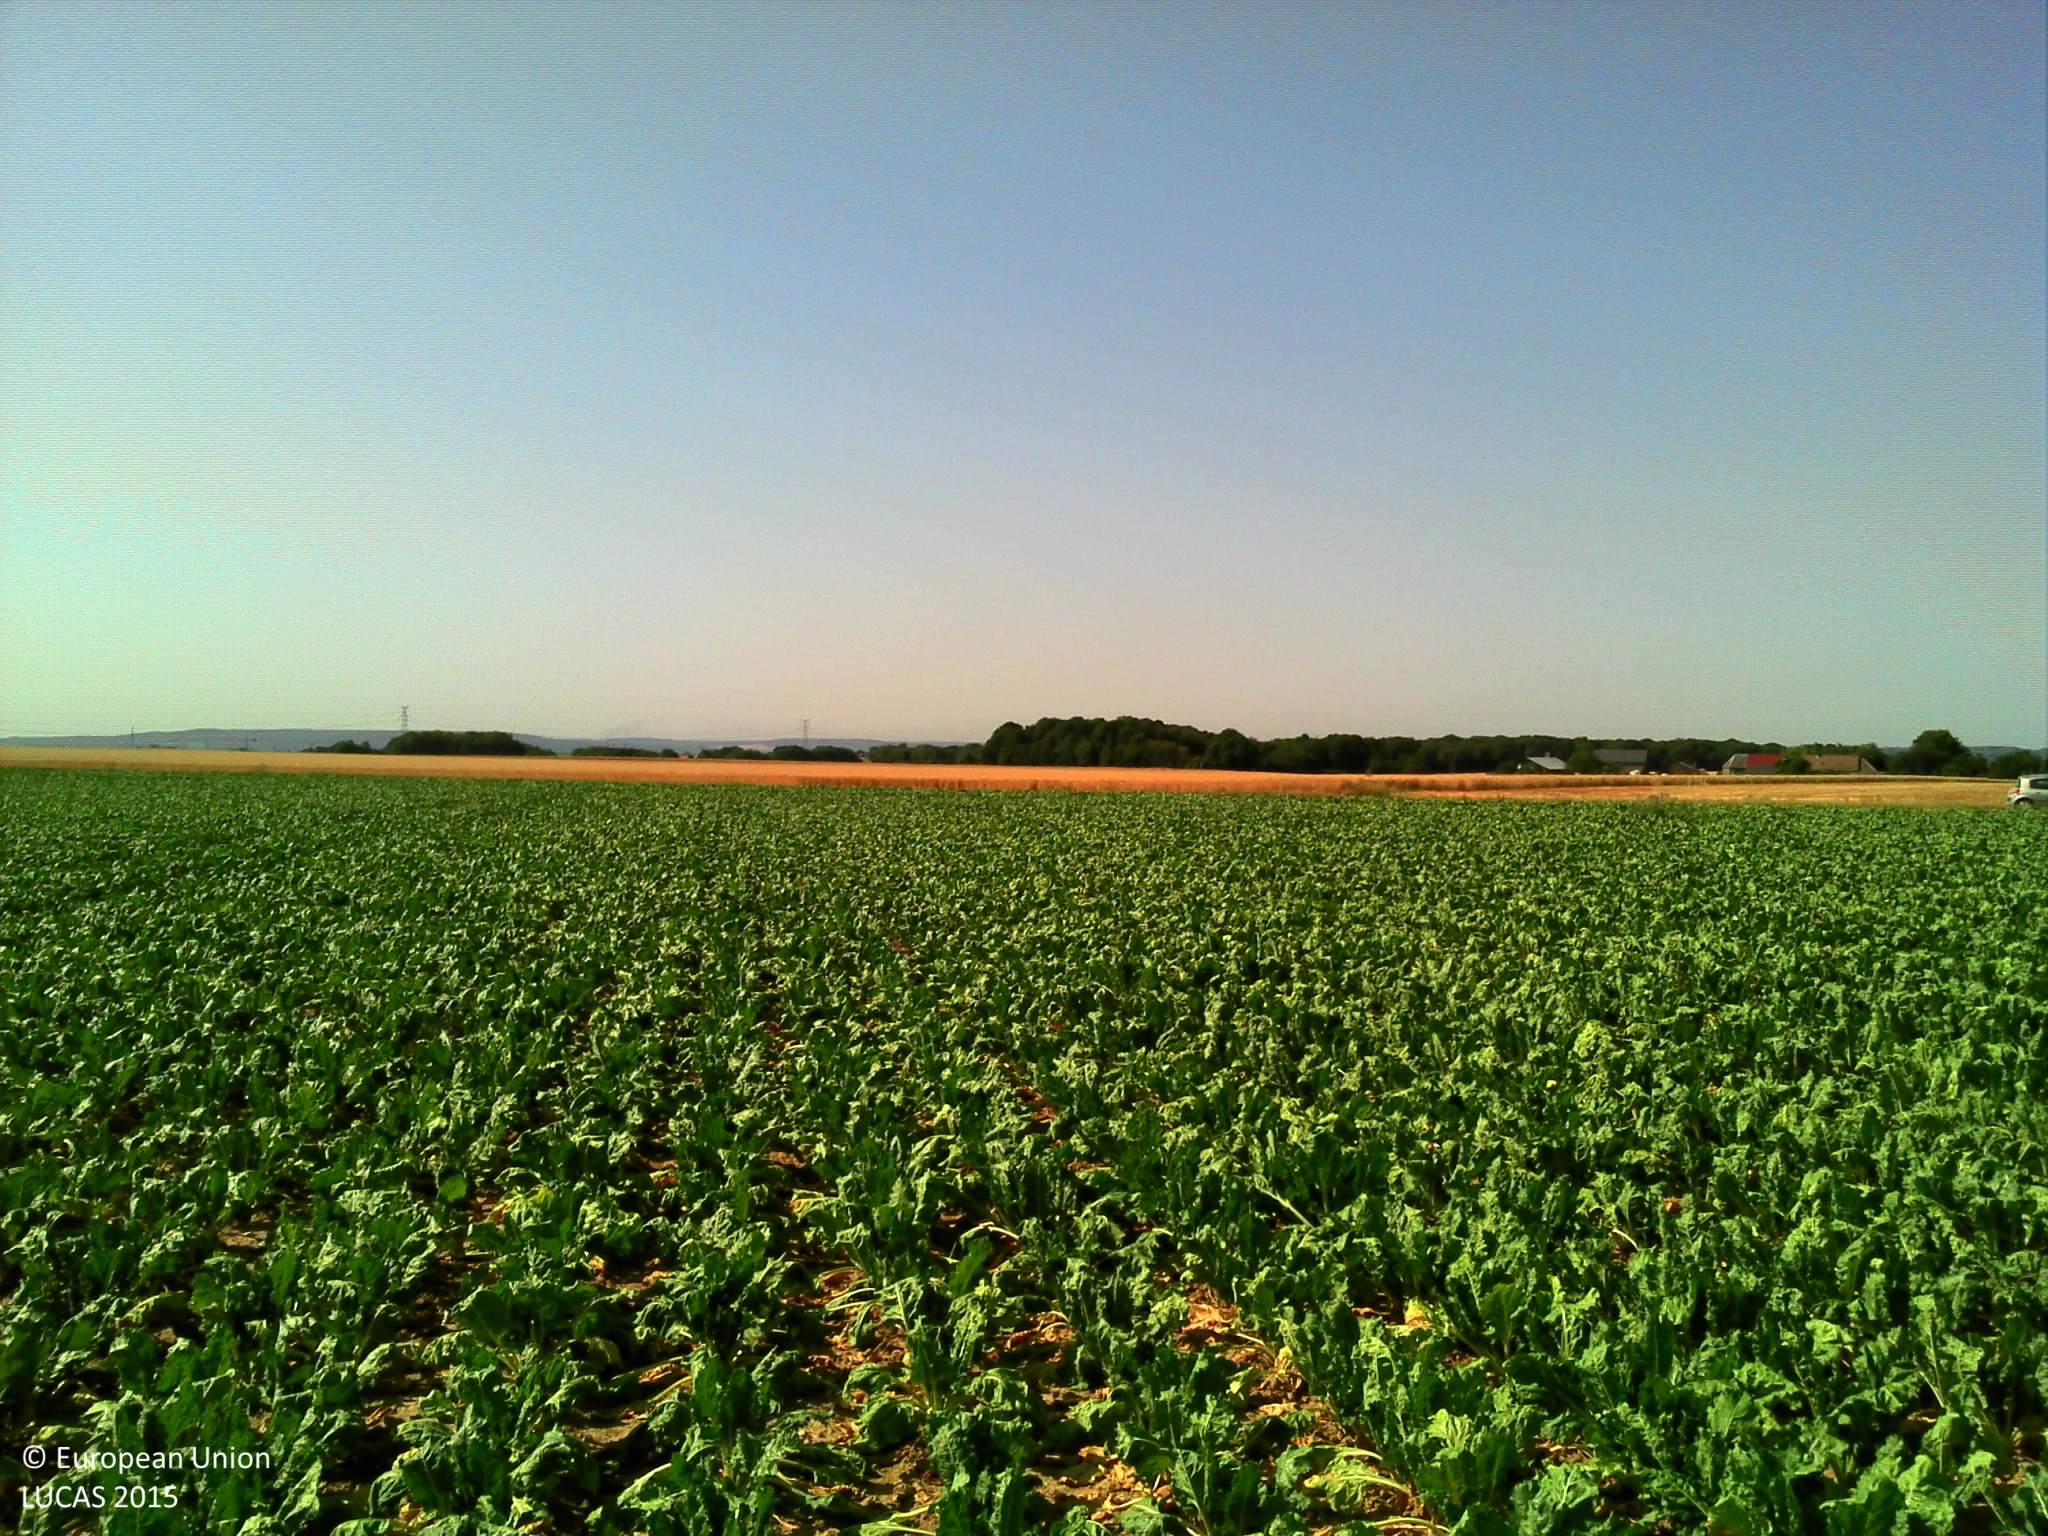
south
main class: Cropland
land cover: Sugar beet
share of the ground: > 75 %
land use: Agriculture (excluding fallow land and kitchen gardens)
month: July
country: FR
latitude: 49.2538
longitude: 2.2794
